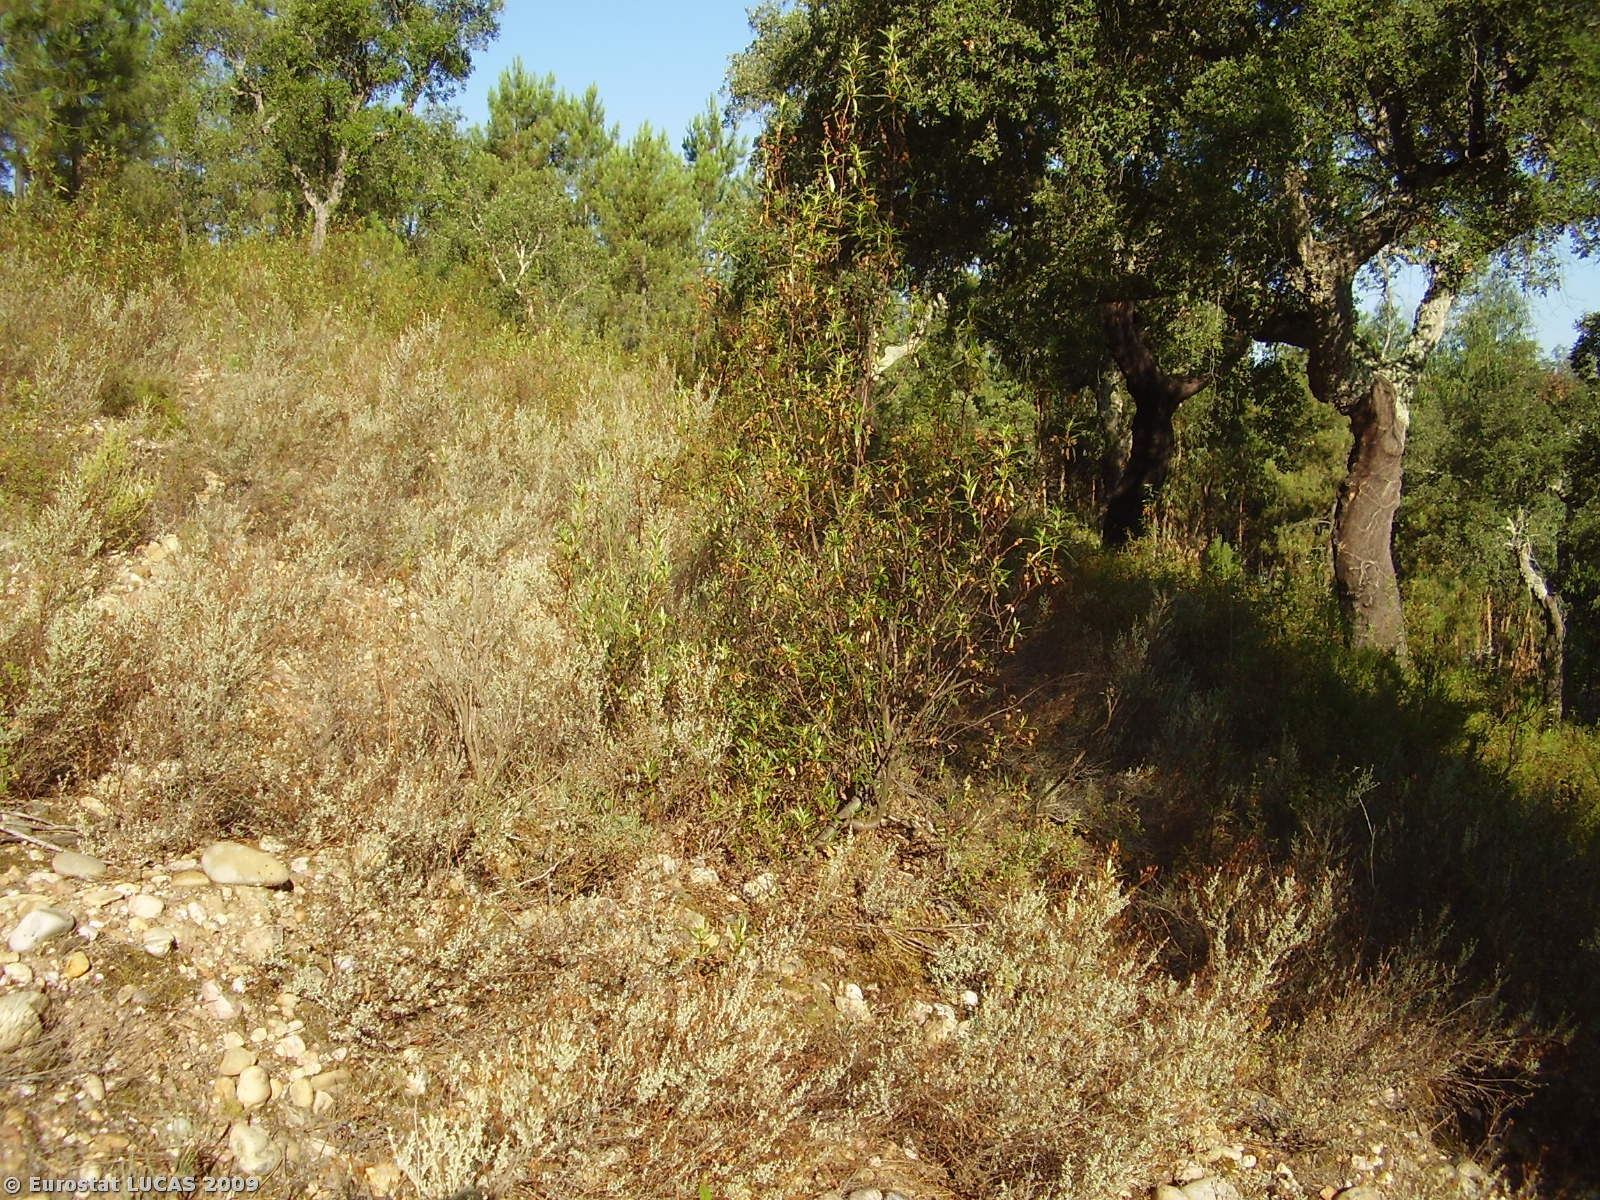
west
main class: Woodland
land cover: Mixed woodland
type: broadleaved evergreen forest
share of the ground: < 10 %
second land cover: Shrubland with sparse tree cover
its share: 25 - 50 %
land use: Forestry
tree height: > 5 m
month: July
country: PT
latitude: 39.3791
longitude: -8.1117
